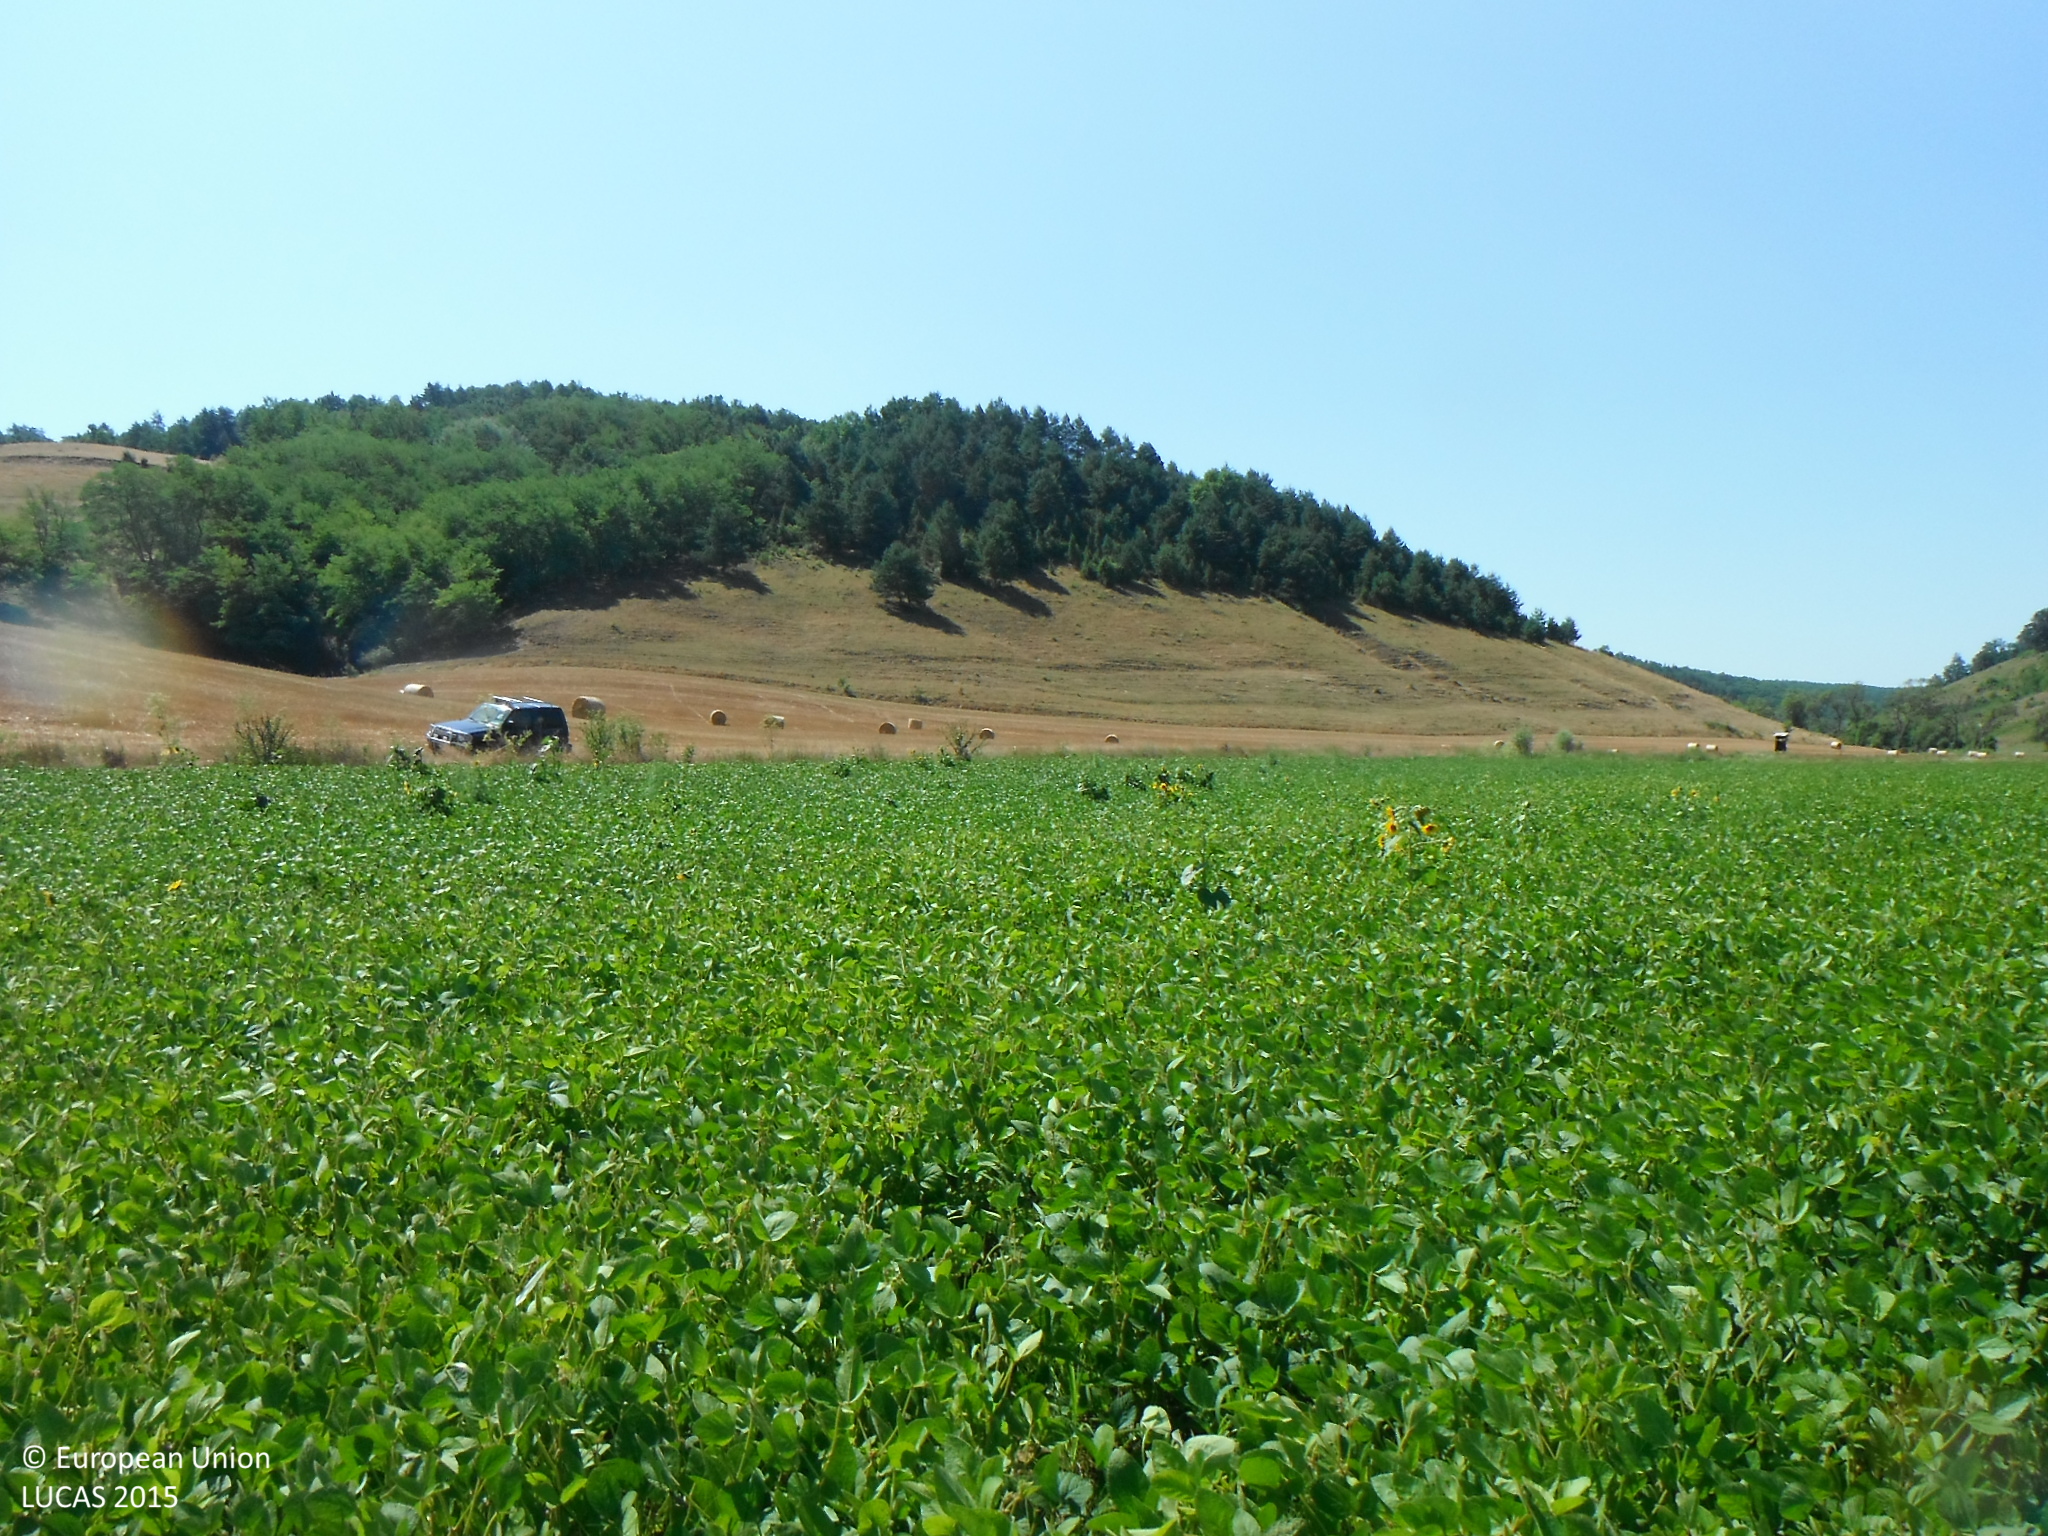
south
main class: Cropland
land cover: Soya
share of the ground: > 75 %
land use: Agriculture (excluding fallow land and kitchen gardens)
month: July
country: SK
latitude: 48.2361
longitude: 20.0329
